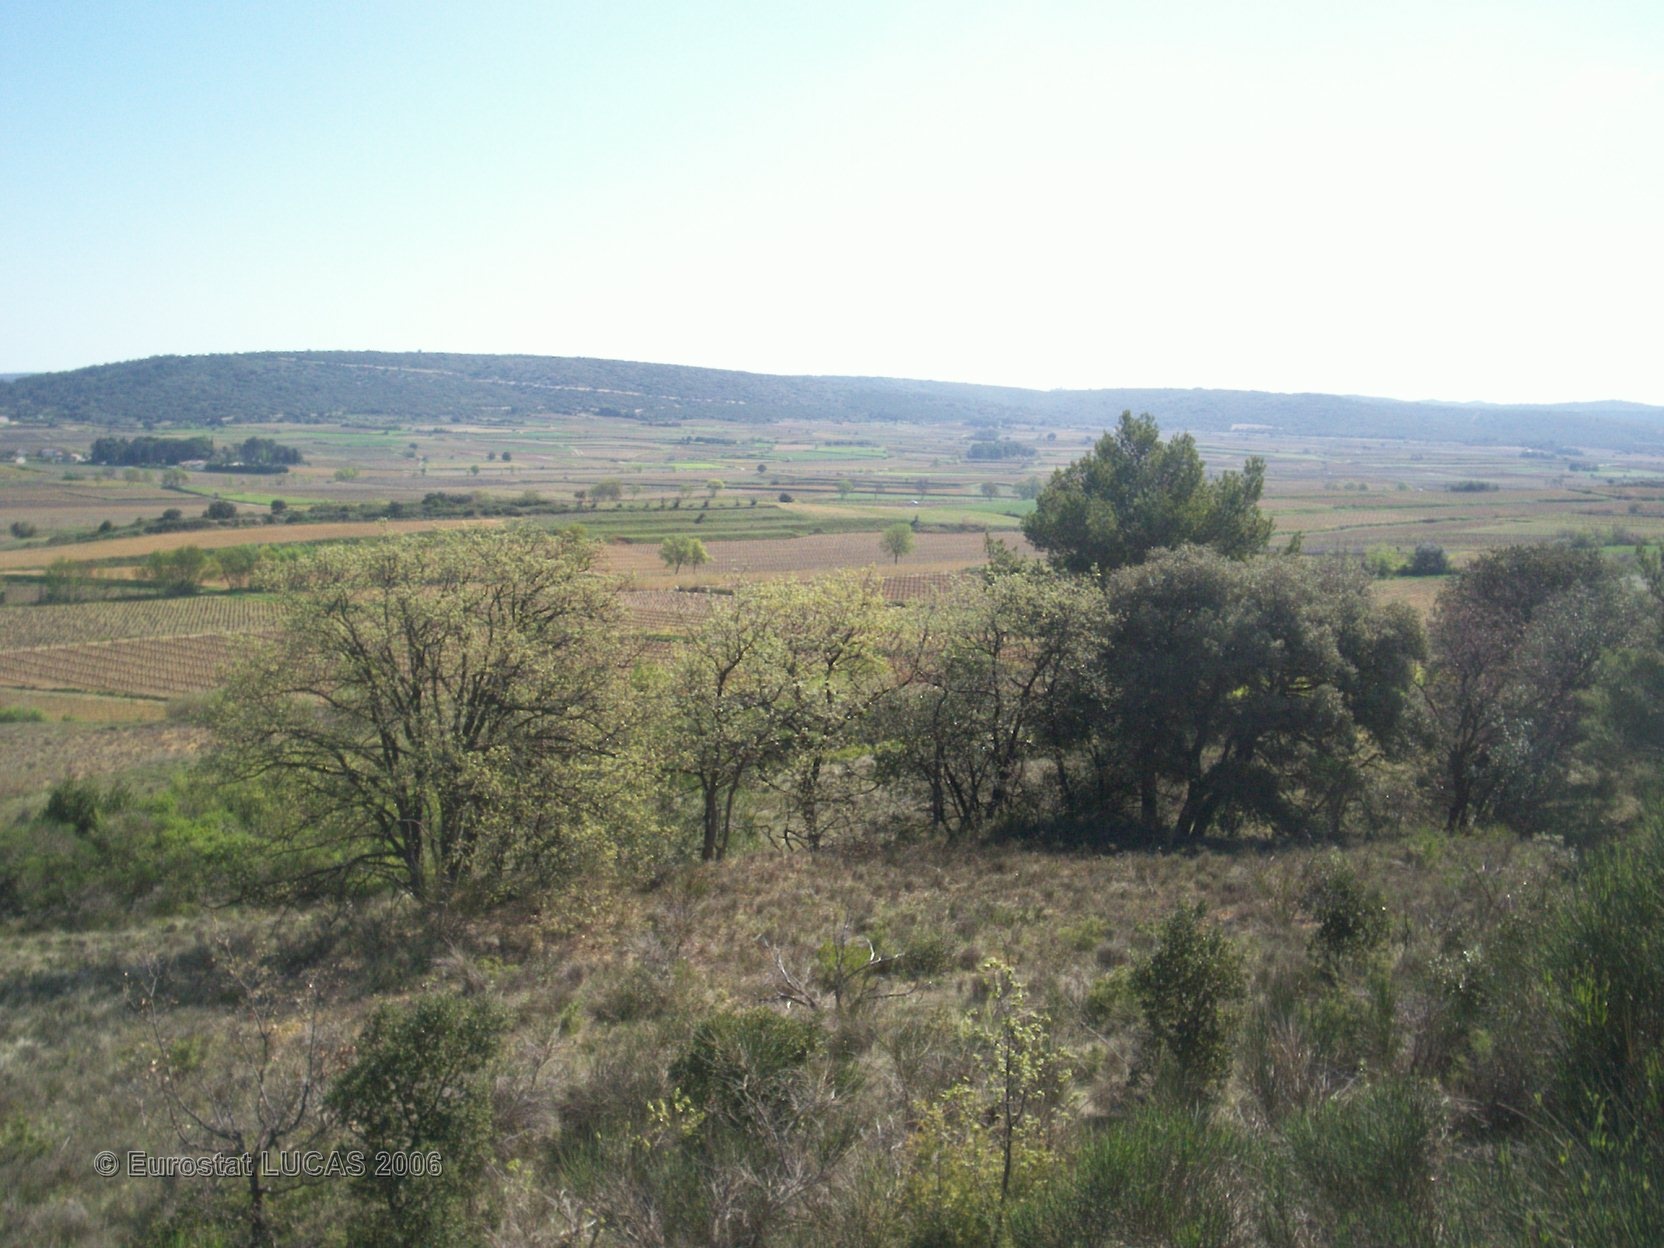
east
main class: Grassland
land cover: Grassland with sparse tree/shrub cover
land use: Unused
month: April
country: FR
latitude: 43.6057
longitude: 3.5293
